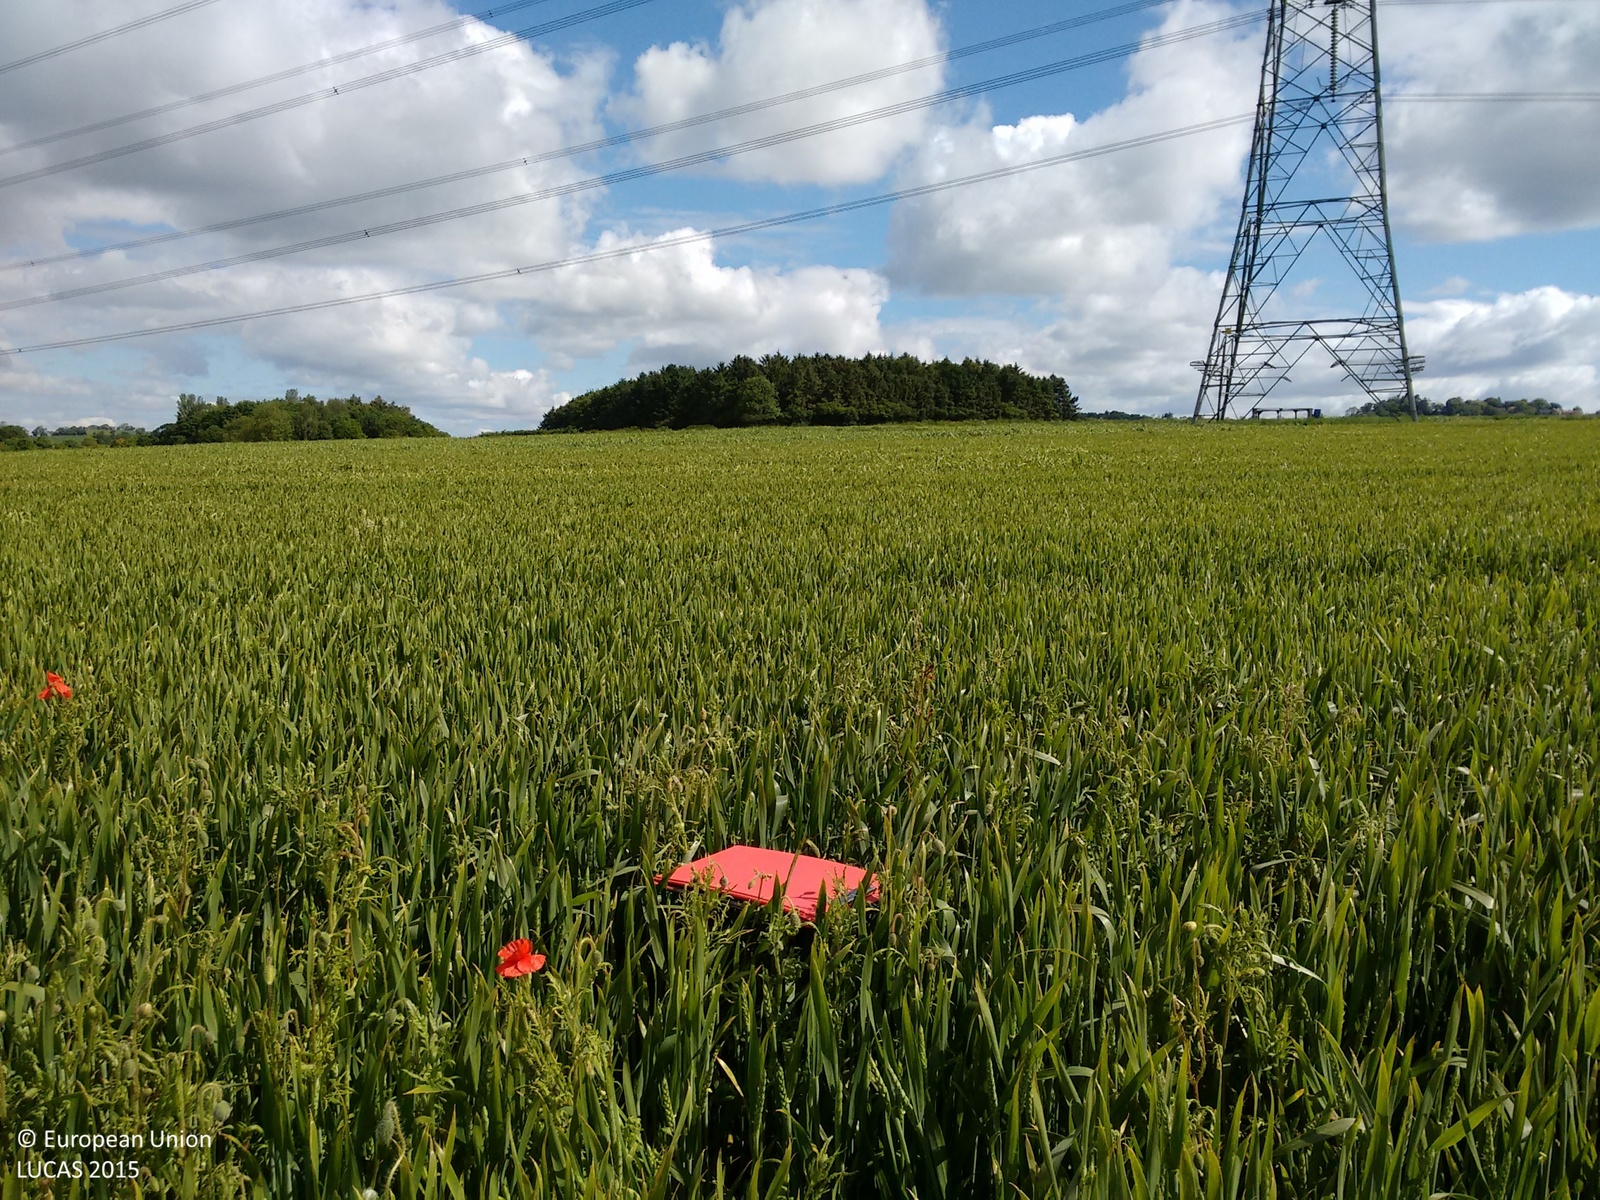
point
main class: Cropland
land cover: Common wheat
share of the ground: > 75 %
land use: Agriculture (excluding fallow land and kitchen gardens)
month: June
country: GB
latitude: 54.1184
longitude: -1.1671
